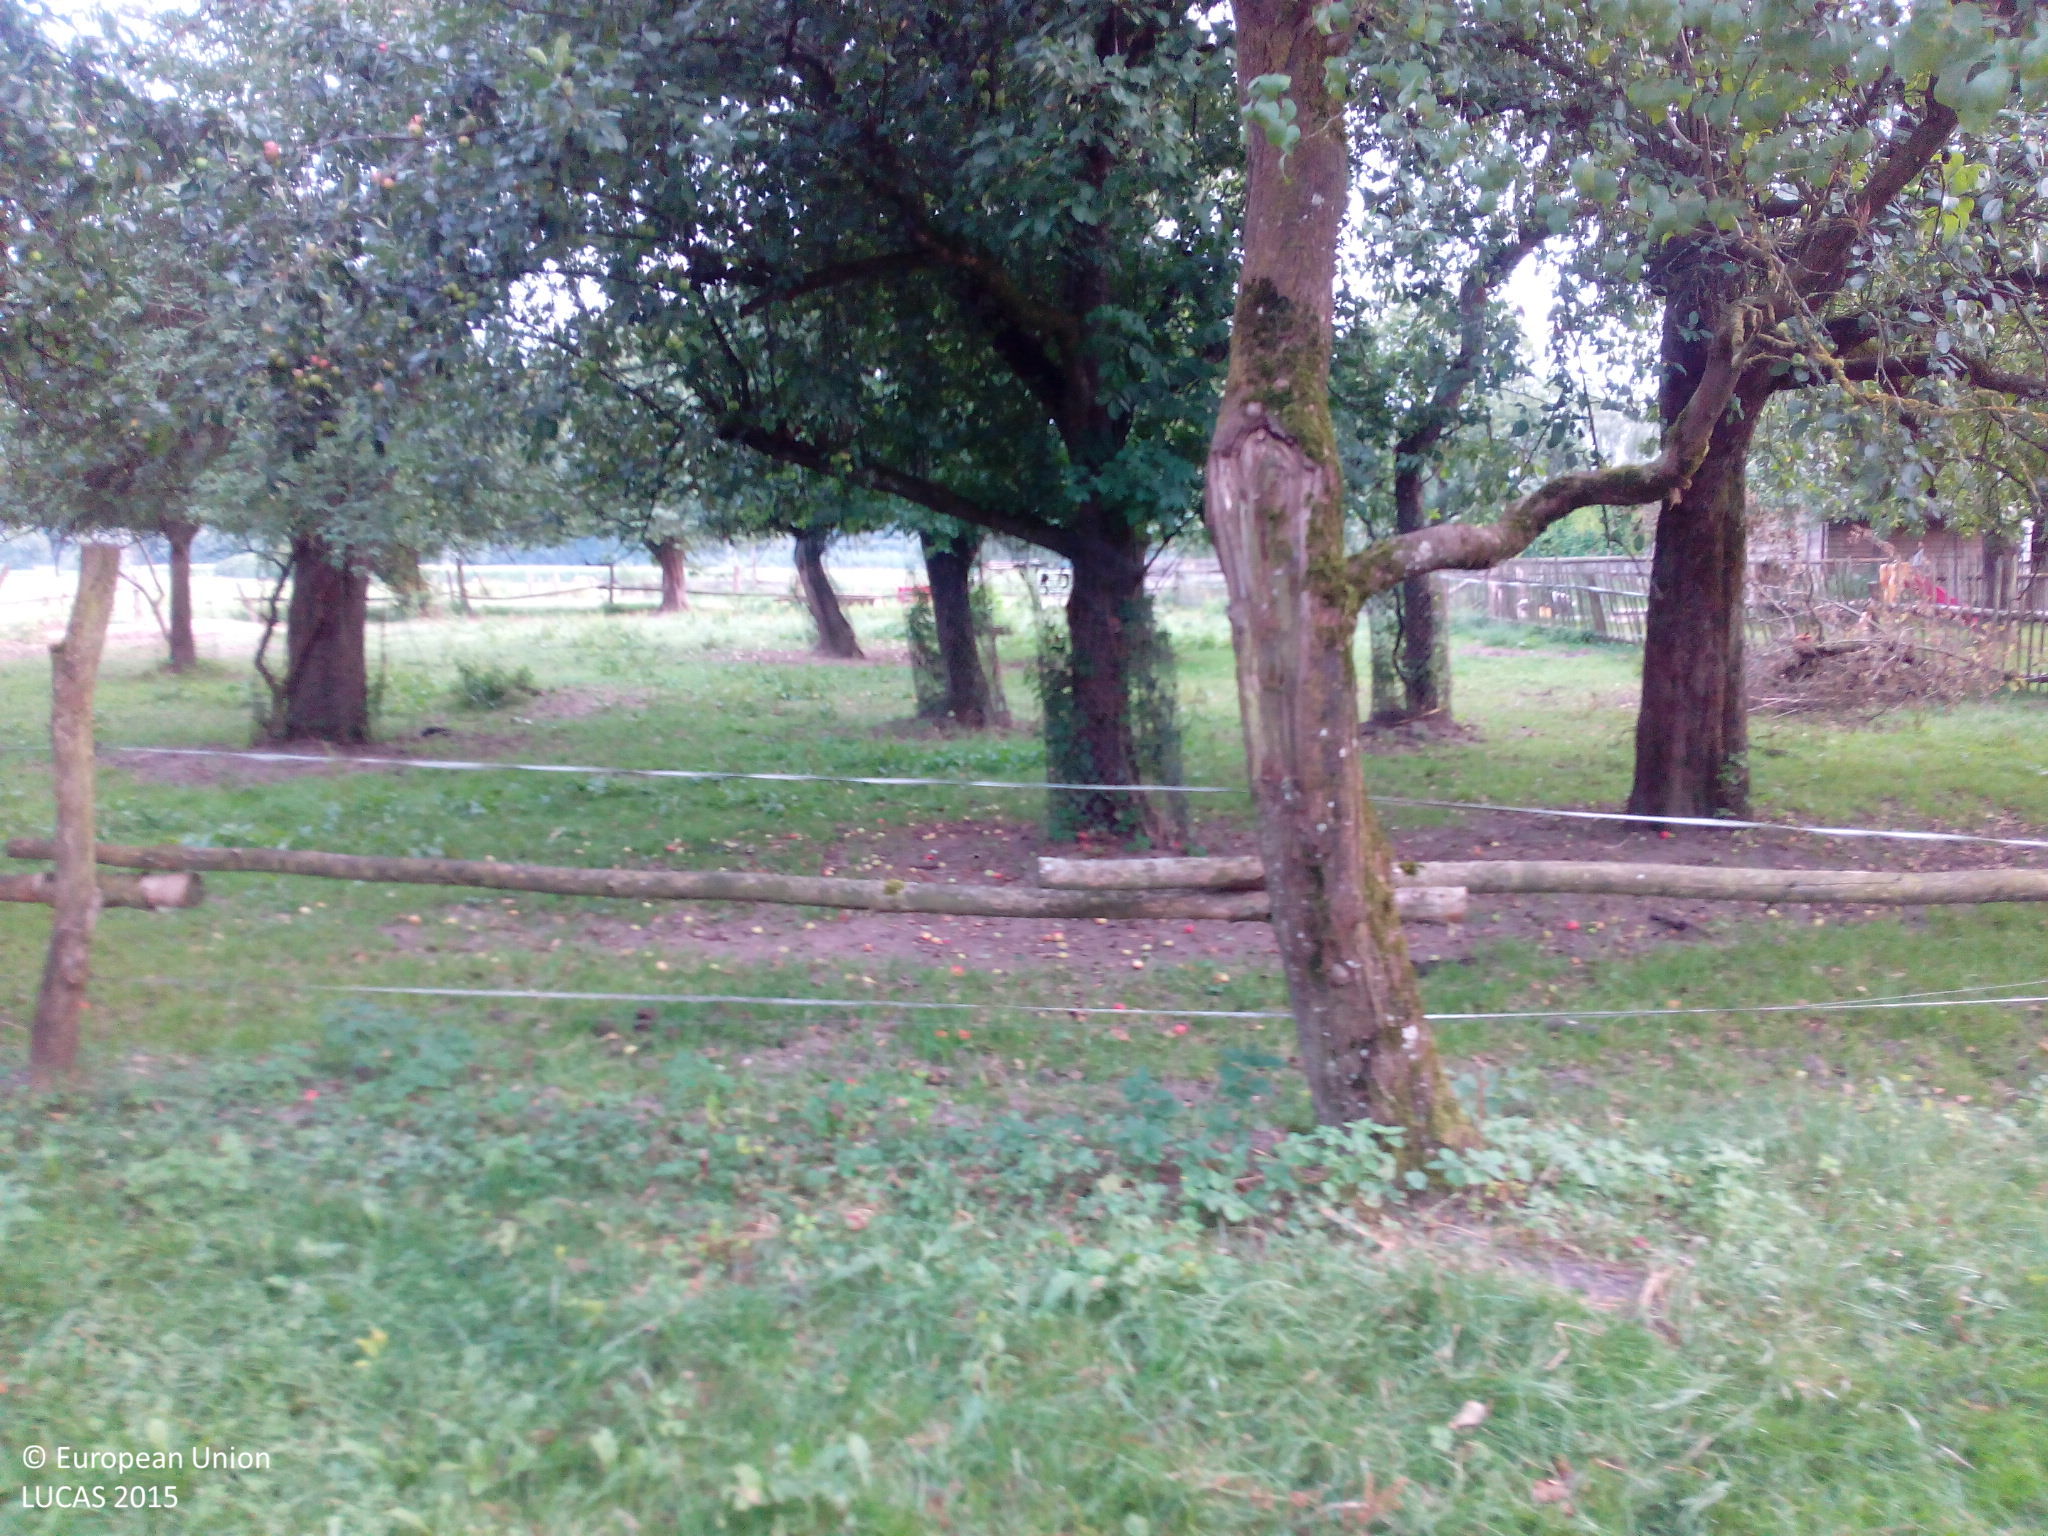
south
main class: Grassland
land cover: Spontaneously vegetated surfaces
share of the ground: 25 - 50 %
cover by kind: unconsolidated bare surface 60 %, herbaceous plants 40 %
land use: Agriculture (excluding fallow land and kitchen gardens)
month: July
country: DE
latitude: 48.1878
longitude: 12.8103
